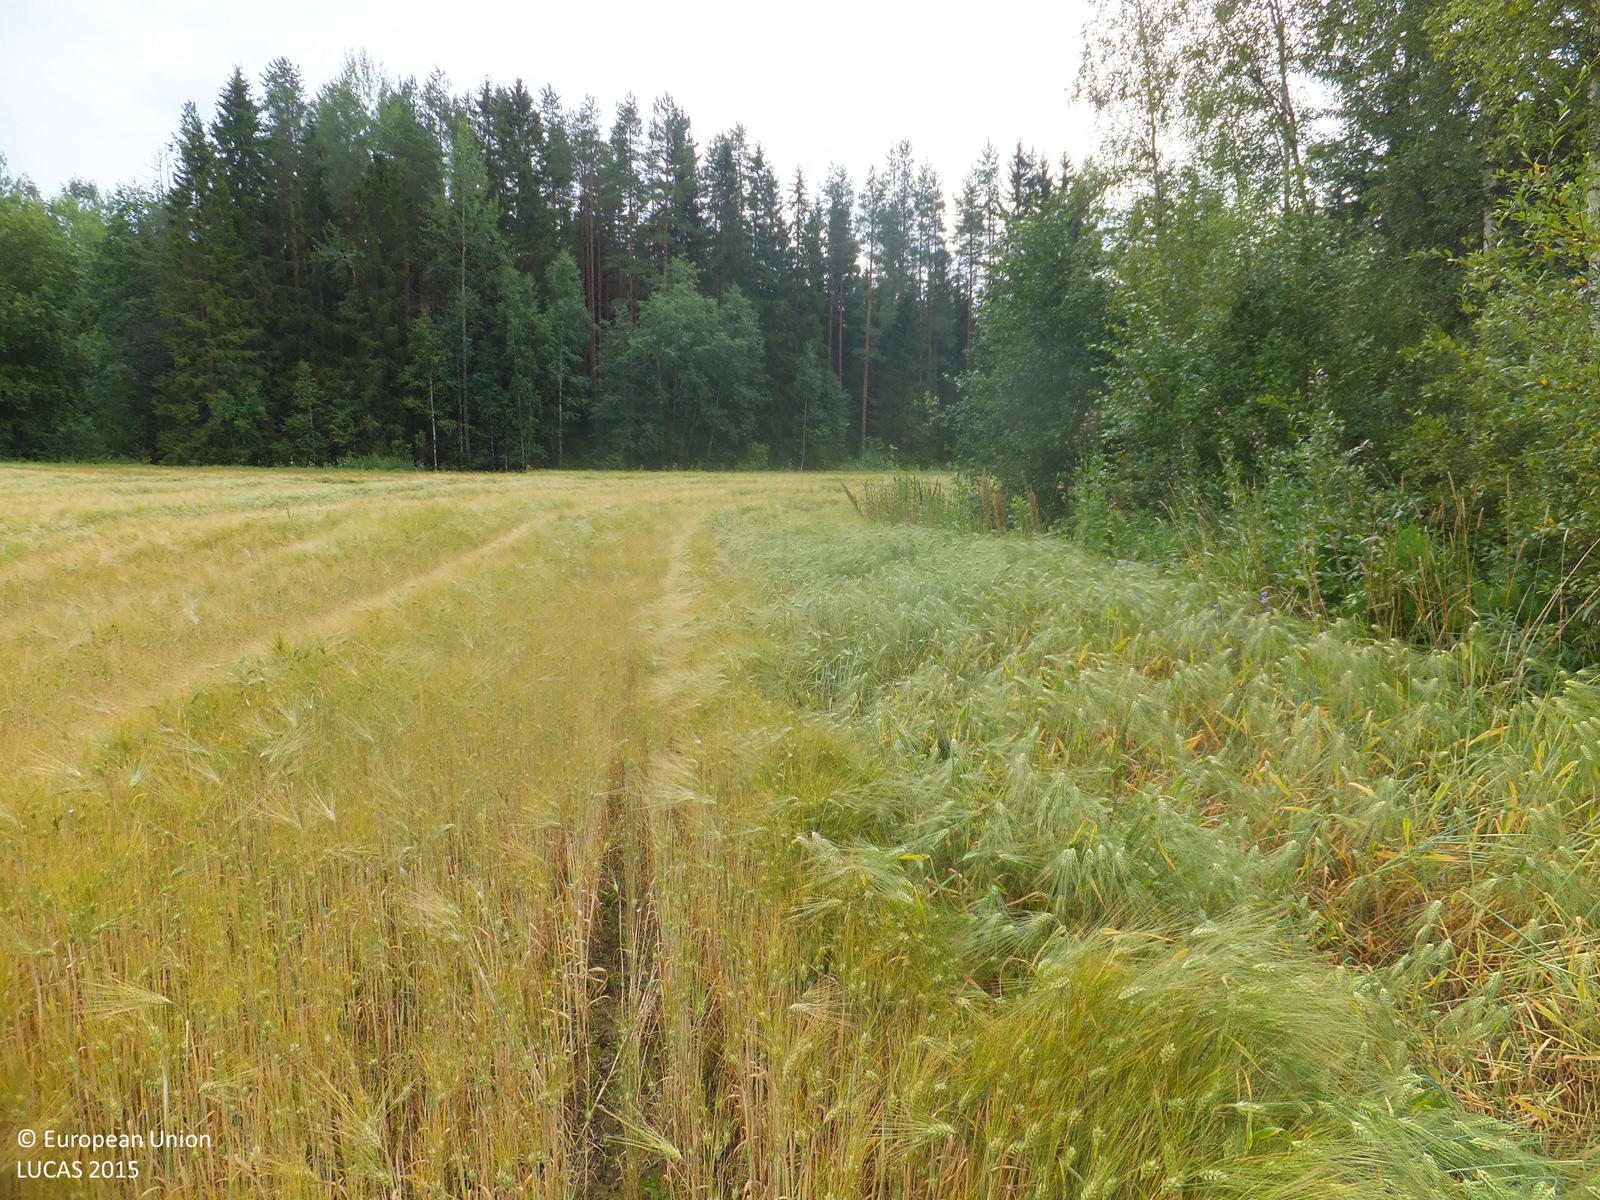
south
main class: Cropland
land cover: Barley
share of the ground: > 75 %
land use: Agriculture (excluding fallow land and kitchen gardens)
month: August
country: FI
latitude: 63.0978
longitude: 22.9132
